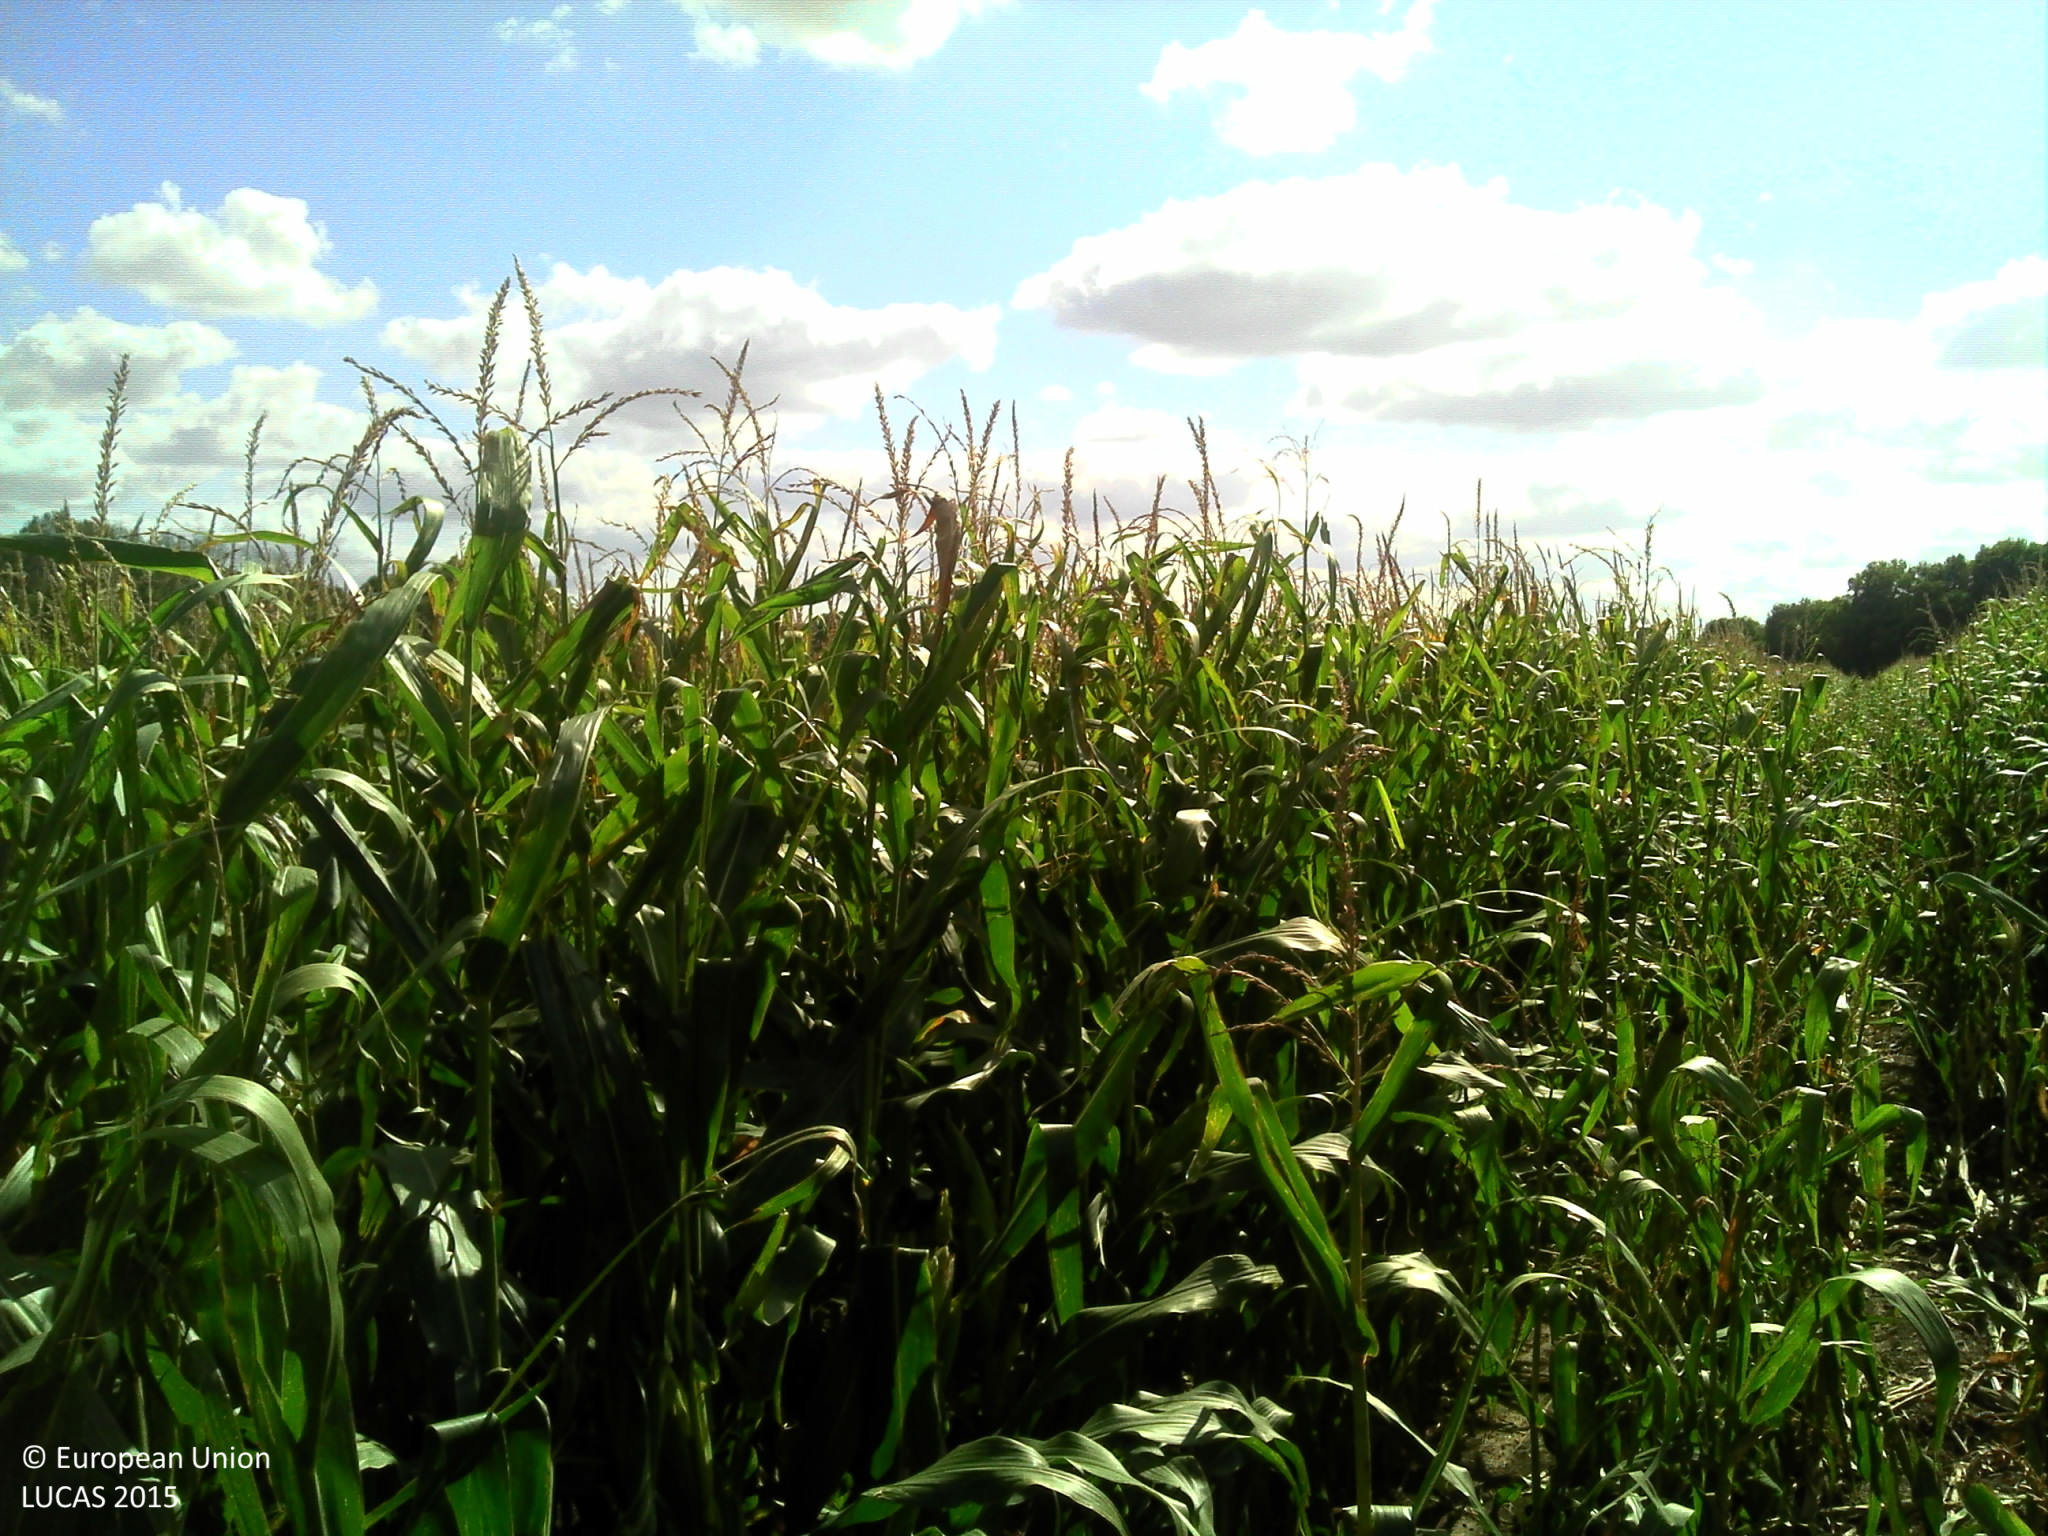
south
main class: Cropland
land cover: Maize
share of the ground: > 75 %
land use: Agriculture (excluding fallow land and kitchen gardens)
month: September
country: FR
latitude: 46.9272
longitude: 1.6230
